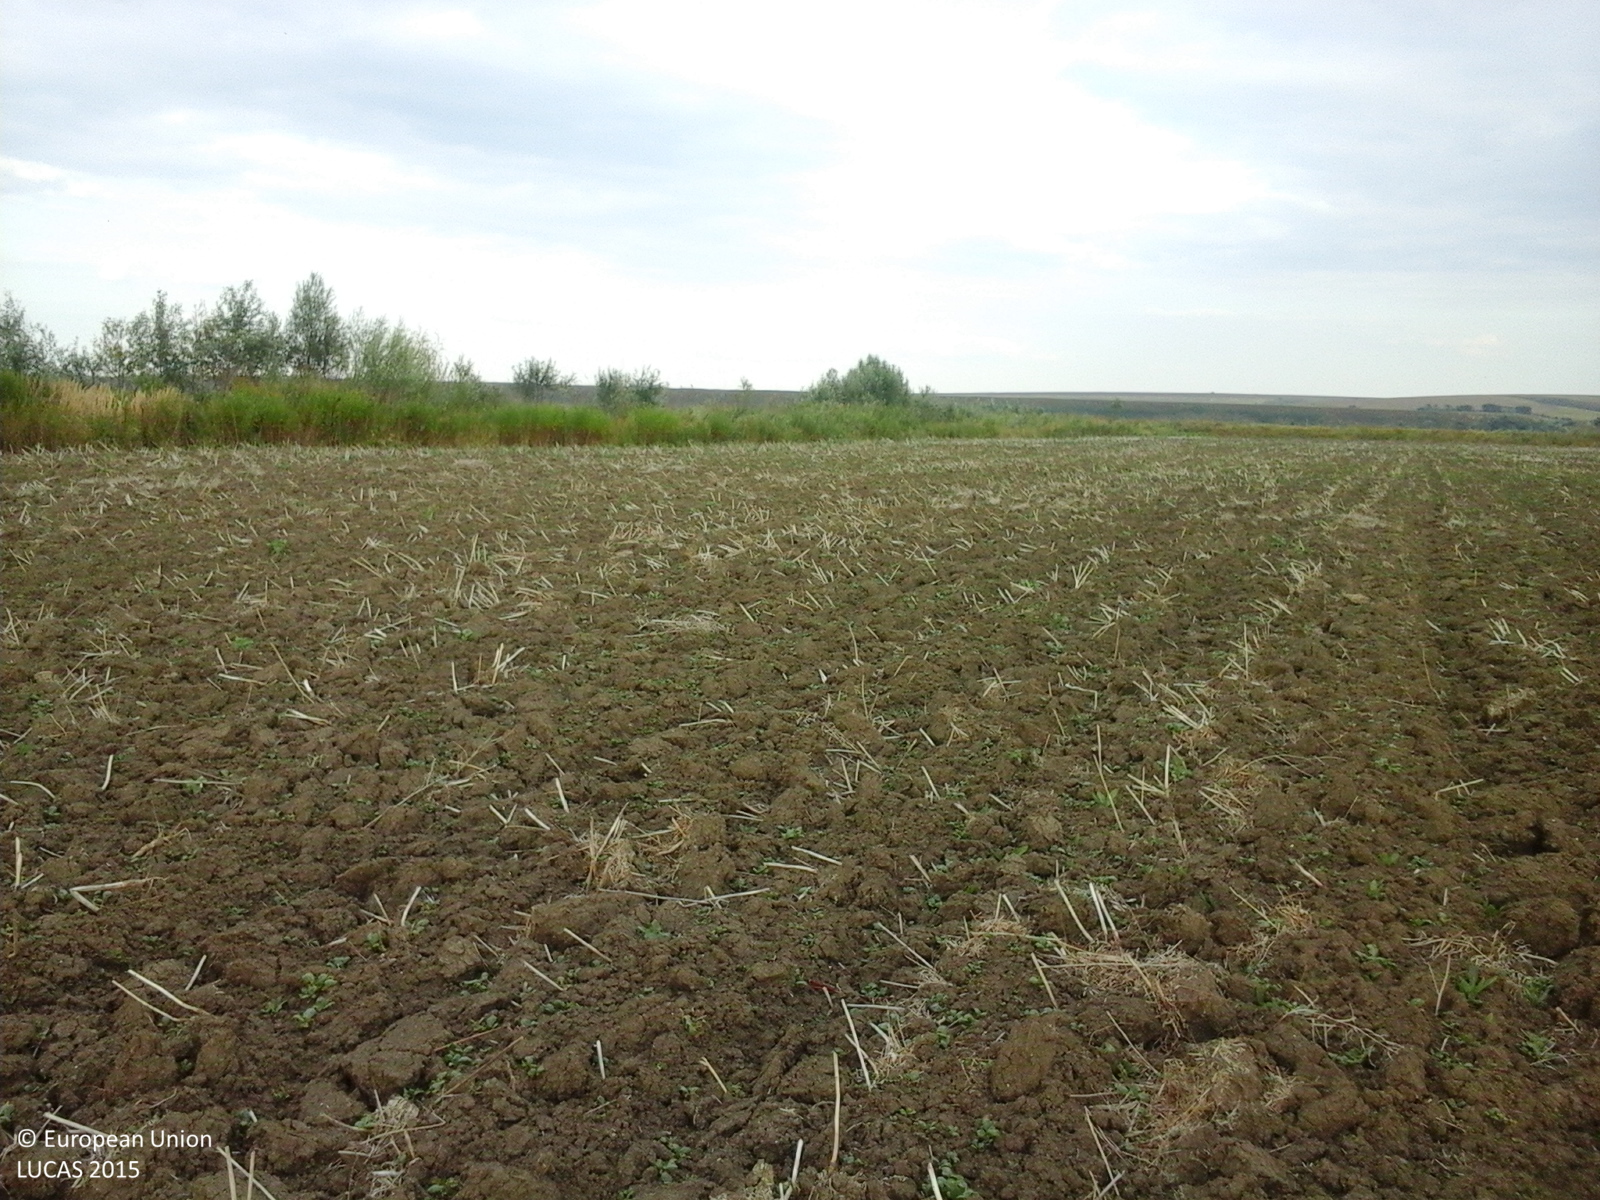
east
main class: Cropland
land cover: Rape and turnip rape
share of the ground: < 10 %
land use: Agriculture (excluding fallow land and kitchen gardens)
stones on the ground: < 10 %
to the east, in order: Rape and turnip rape; Grass margins; Lines of trees; Ditches and canals; Grass margins; Maize
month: August
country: RO
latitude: 44.7422
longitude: 28.0583
